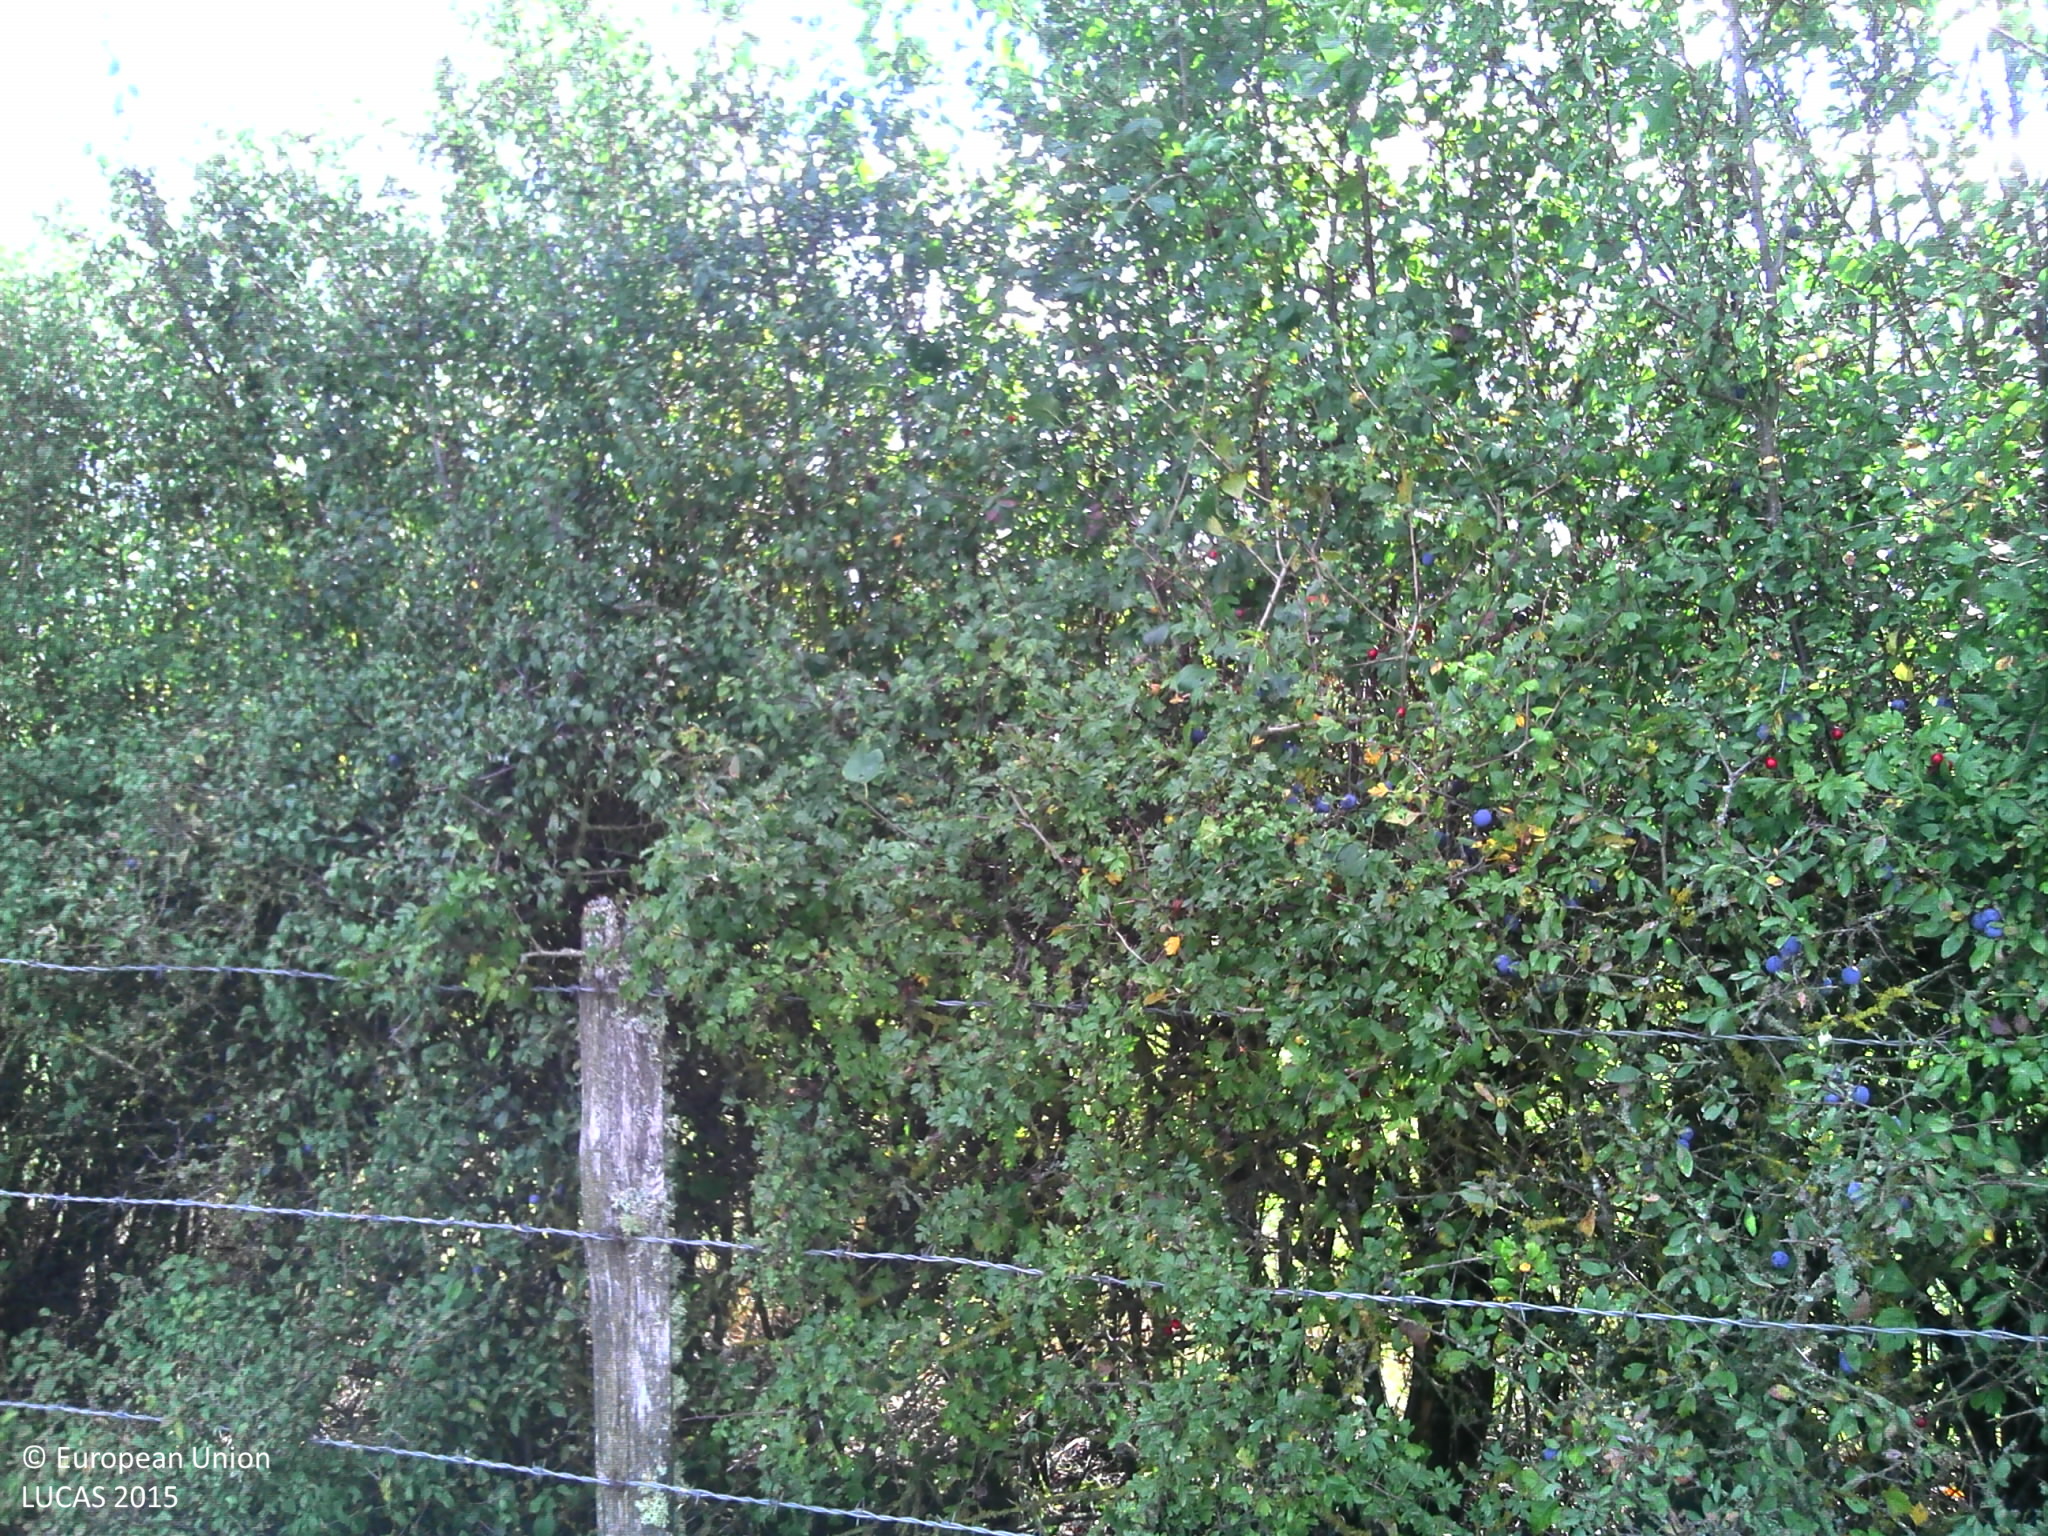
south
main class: Grassland
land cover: Grassland without tree/shrub cover
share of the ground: > 75 %
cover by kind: herbaceous plants 100 %
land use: Agriculture (excluding fallow land and kitchen gardens)
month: September
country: FR
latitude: 47.1967
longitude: 4.3897
